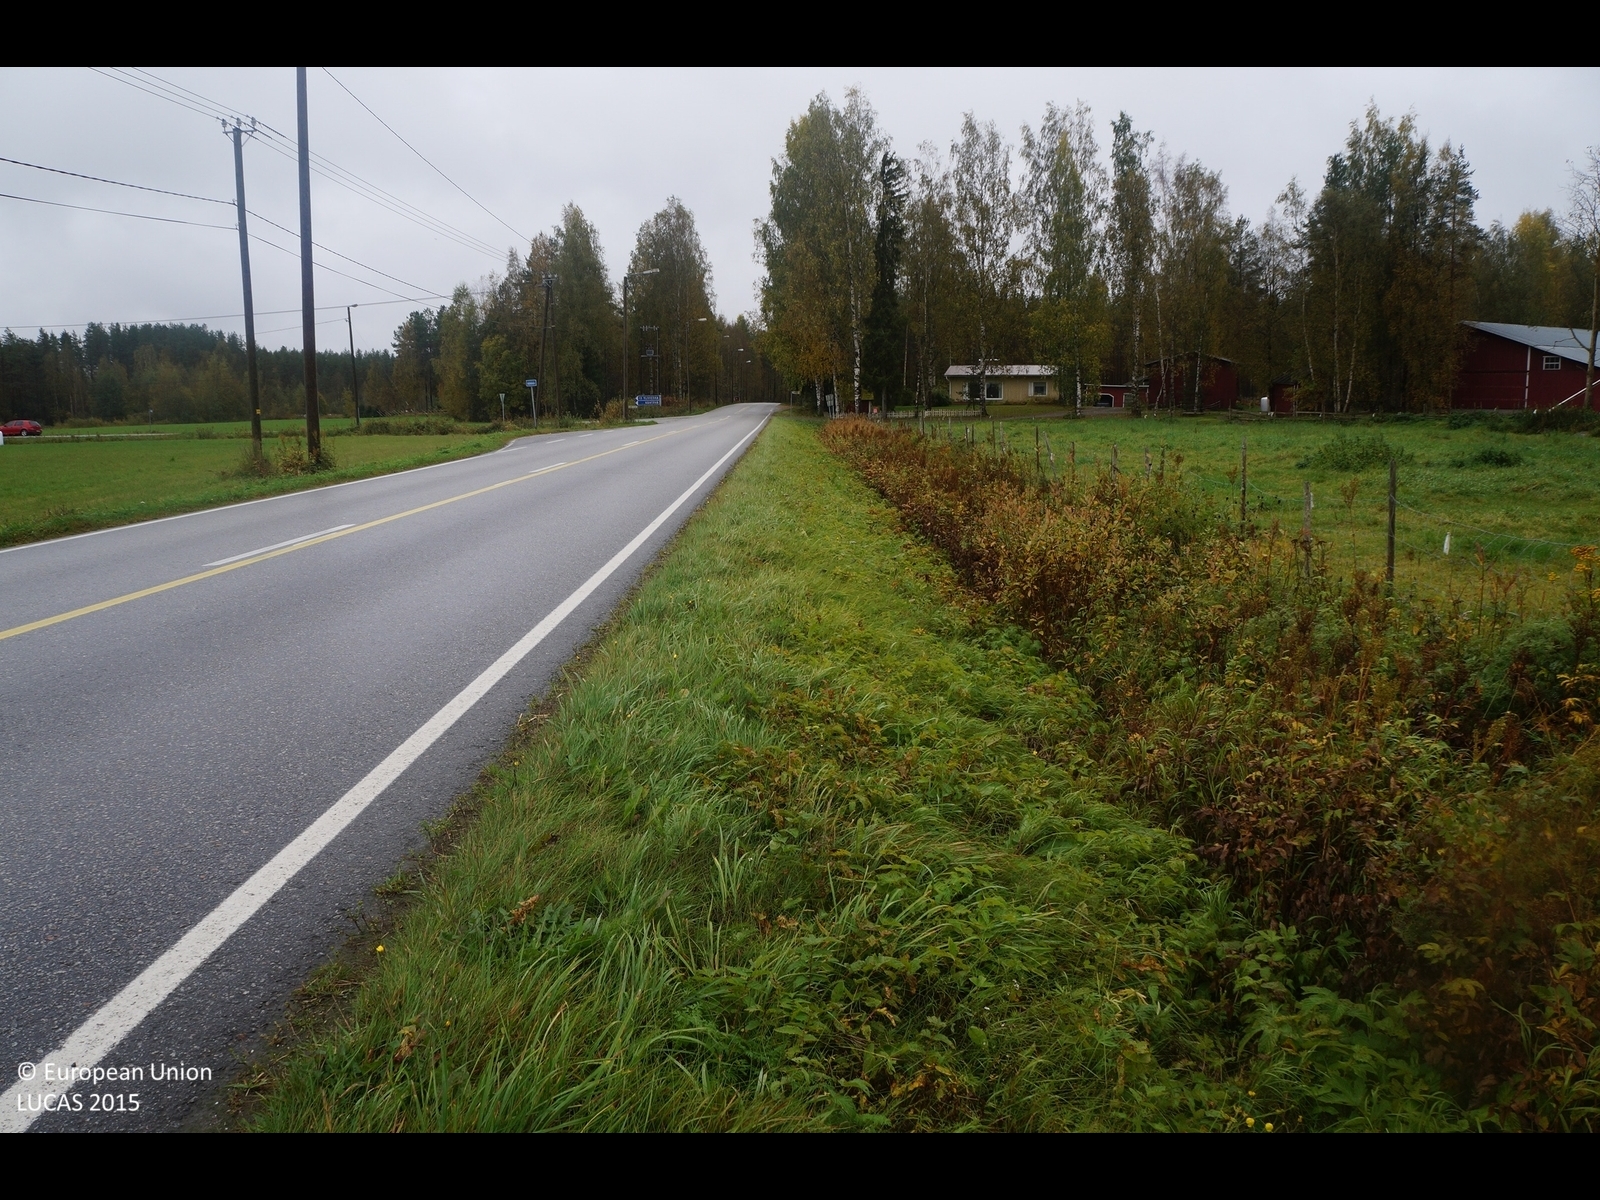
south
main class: Woodland
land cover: Broadleaved woodland
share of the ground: > 75 %
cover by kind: broadleaved forest trees 75 %, herbaceous plants 15 %, shrubs 10 %
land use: Forestry
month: September
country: FI
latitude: 64.1323
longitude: 24.3058
